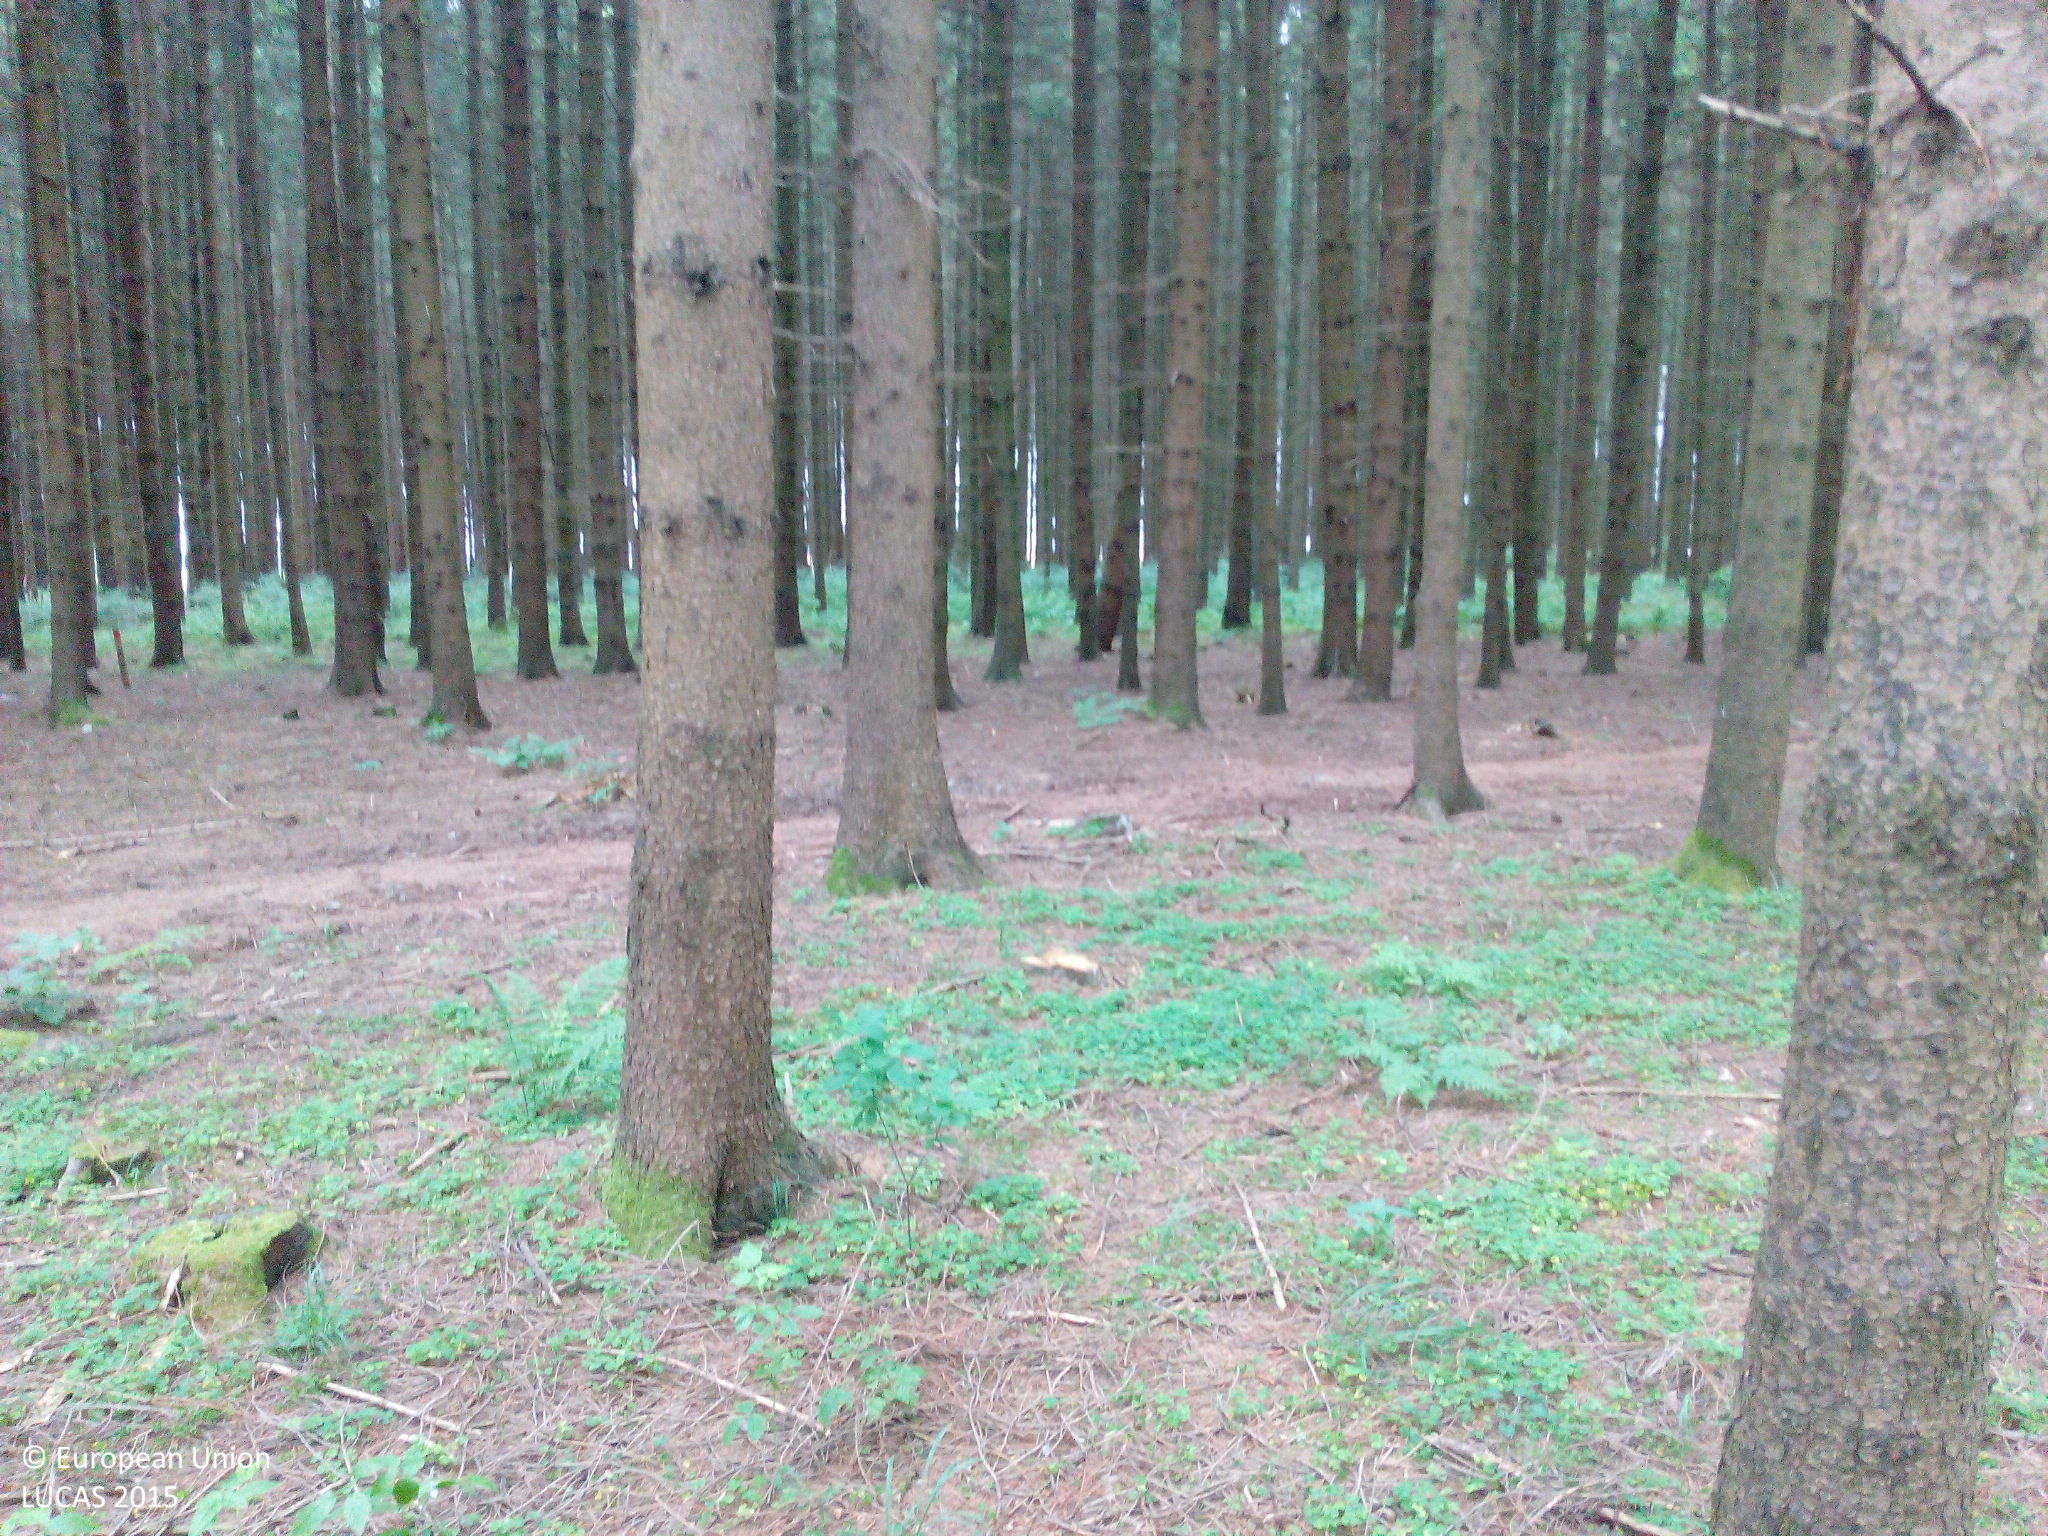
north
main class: Woodland
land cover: Spruce dominated coniferous woodland
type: hemiboreal forest and nemoral coniferous forest and mixed broadleaved-coniferous forest
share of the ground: > 75 %
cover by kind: coniferous forest trees 100 %
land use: Forestry
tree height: > 5 m
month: July
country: DE
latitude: 48.0934
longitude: 10.9527
